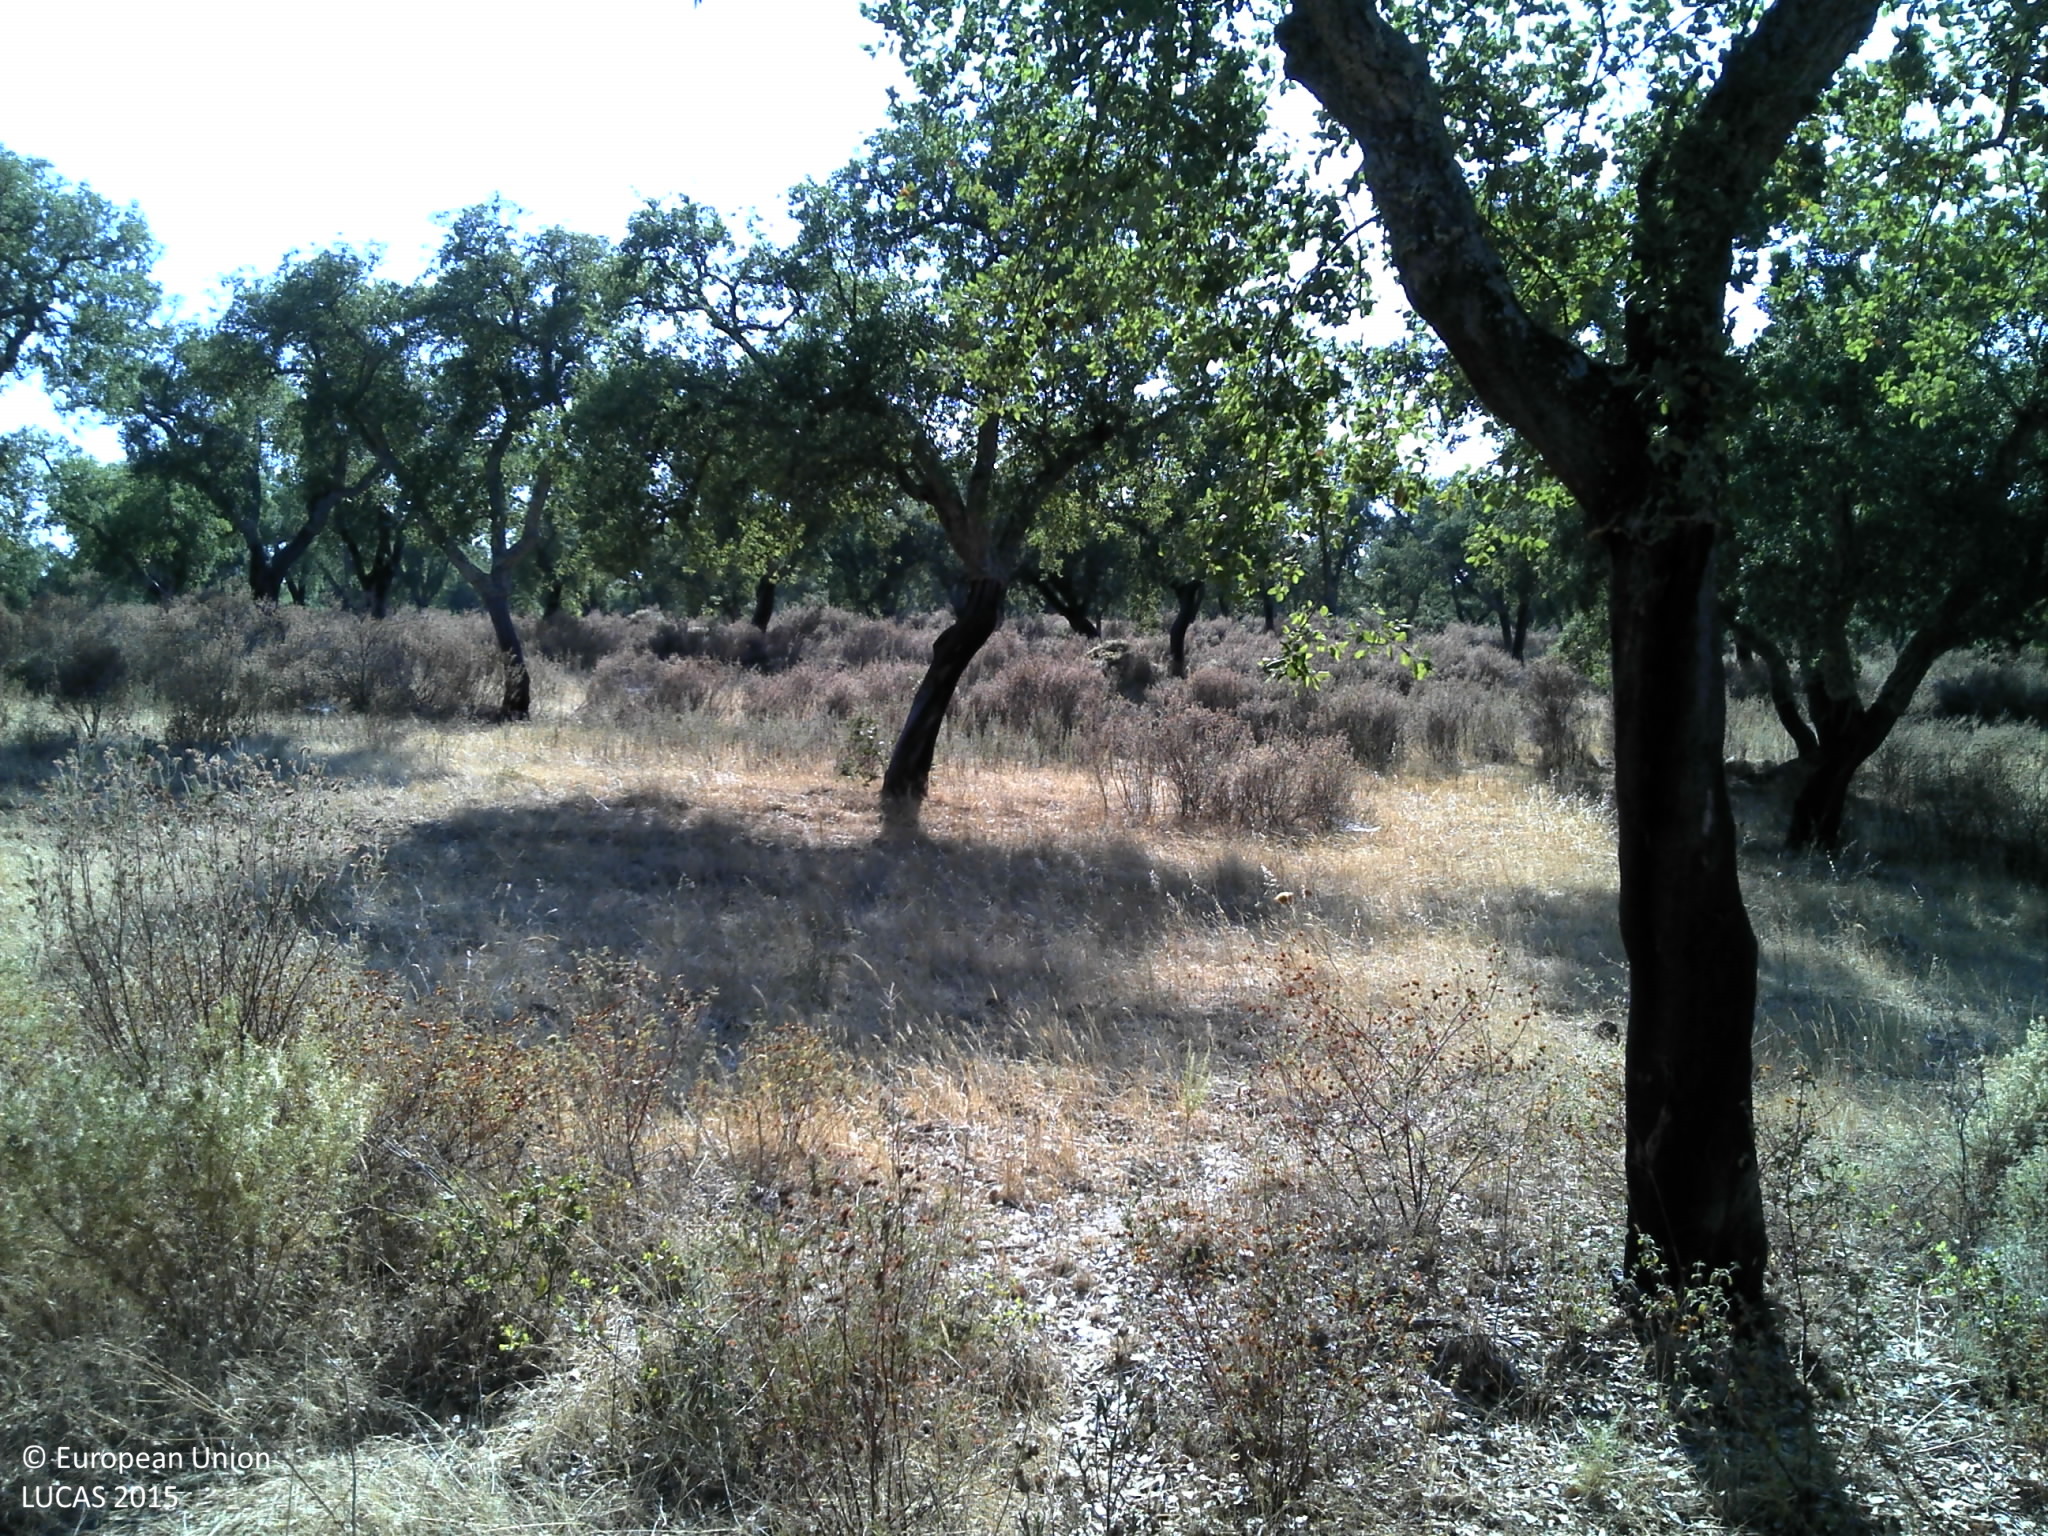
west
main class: Woodland
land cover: Broadleaved woodland
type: broadleaved evergreen forest
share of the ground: 25 - 50 %
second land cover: Shrubland without tree cover
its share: 25 - 50 %
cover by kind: broadleaved forest trees 50 %, shrubs 20 %, herbaceous plants 20 %, unconsolidated bare surface 10 %
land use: Forestry
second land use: Agriculture (excluding fallow land and kitchen gardens)
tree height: > 5 m
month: July
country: PT
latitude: 38.5305
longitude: -7.7112
